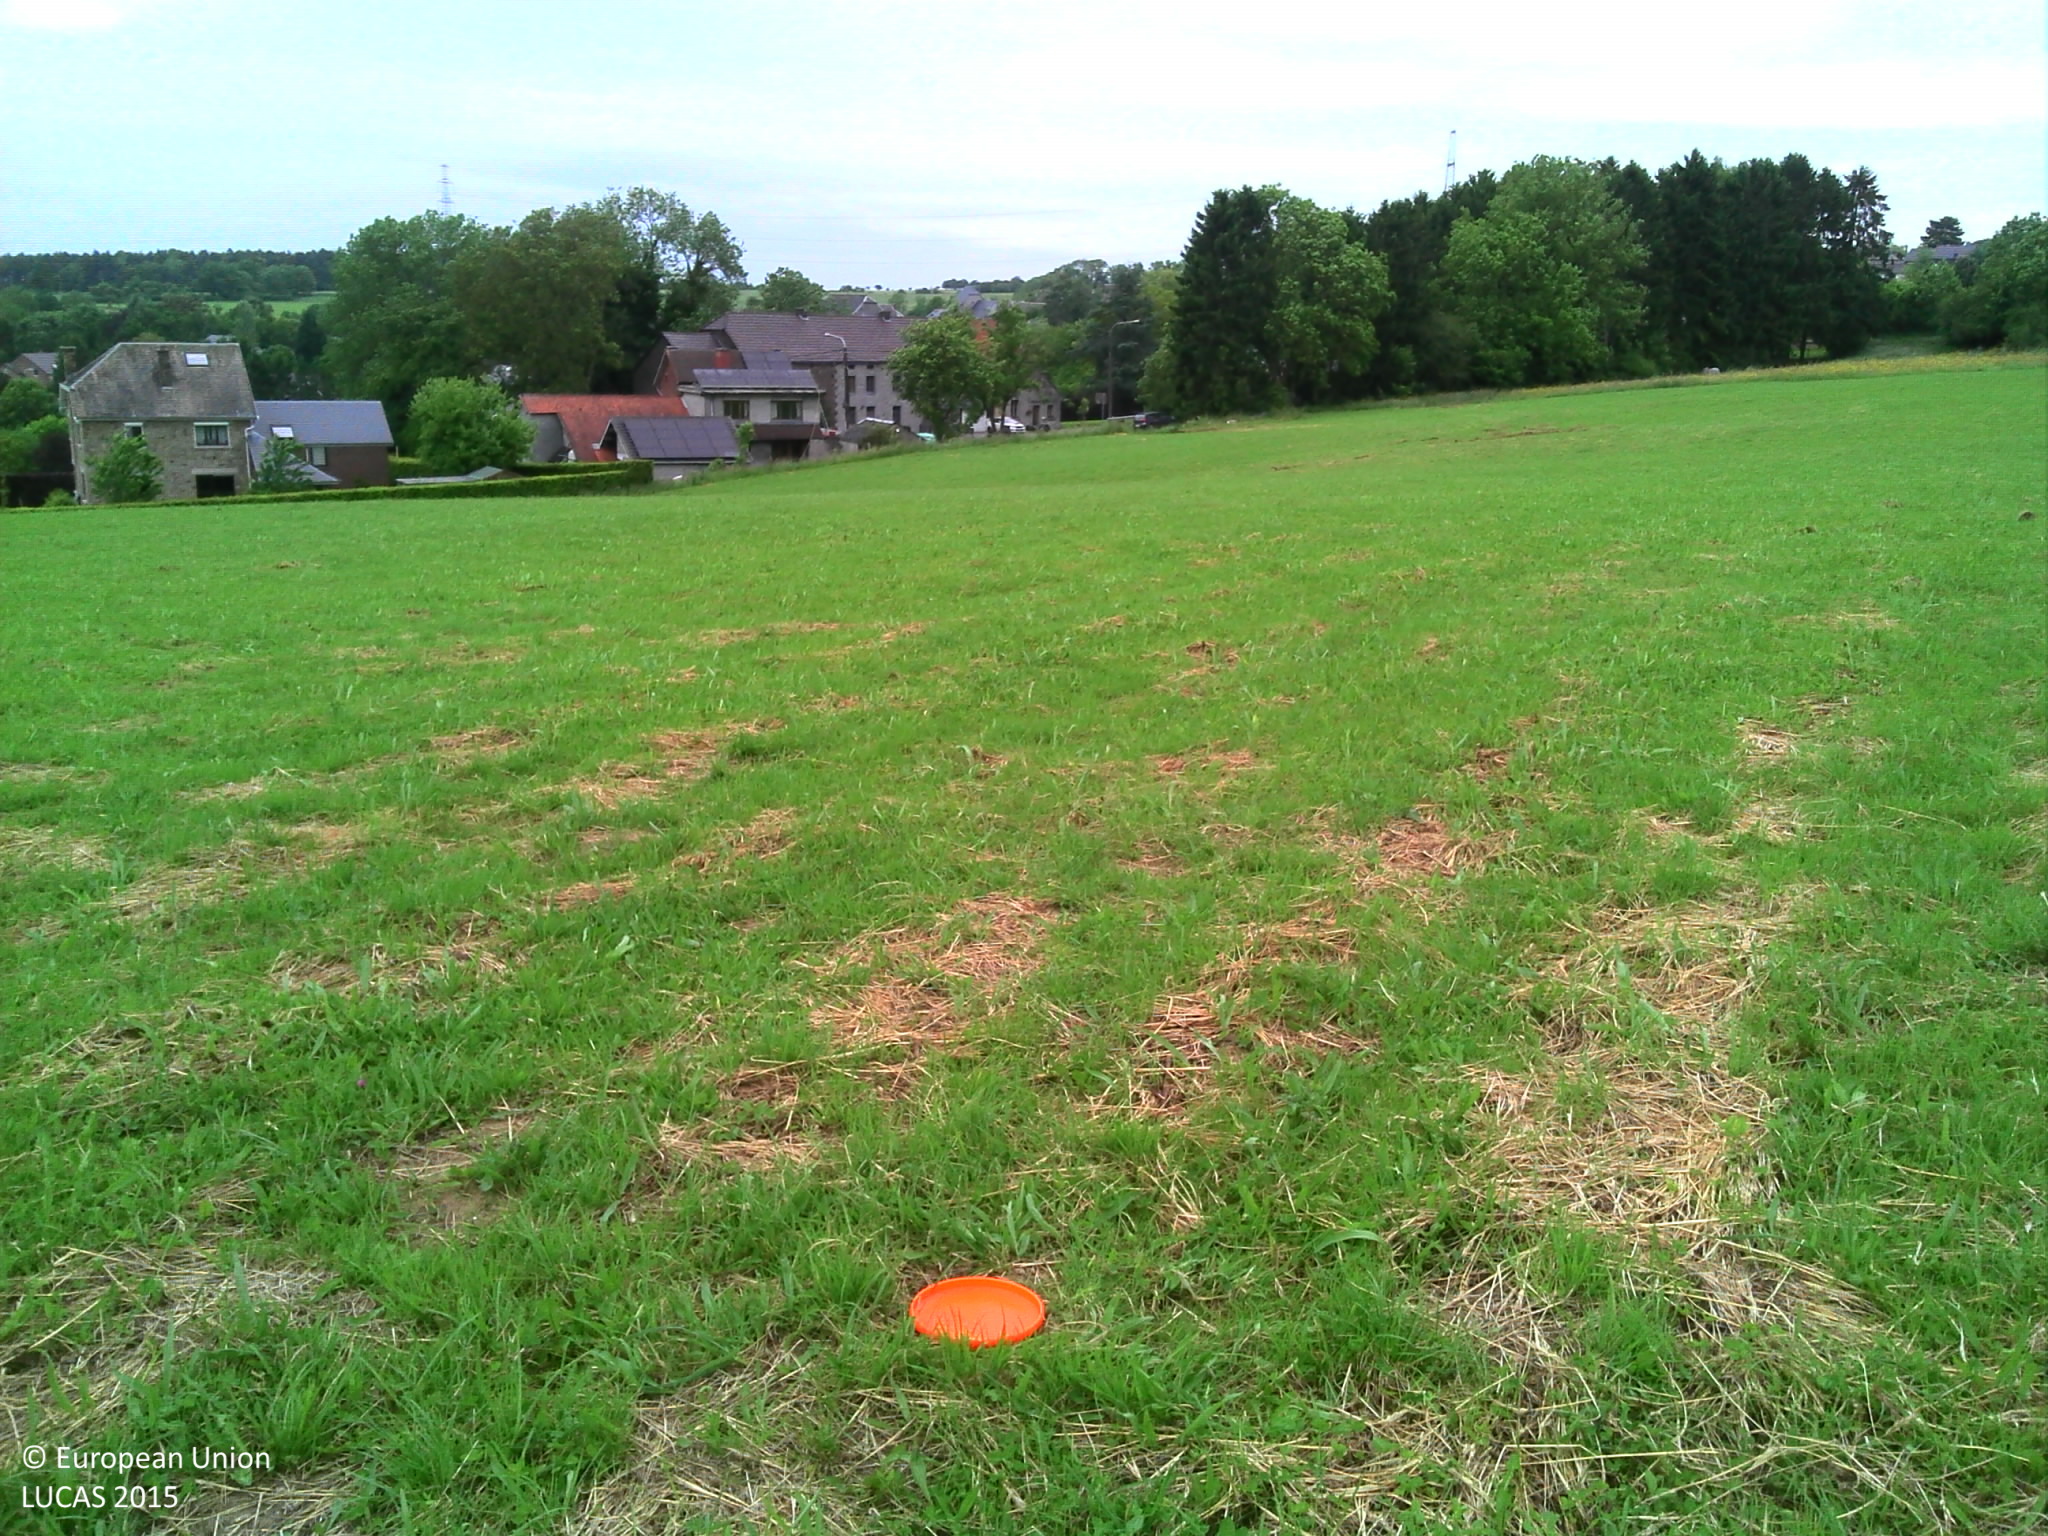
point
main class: Grassland
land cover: Grassland without tree/shrub cover
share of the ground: > 75 %
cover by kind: herbaceous plants 100 %
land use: Agriculture (excluding fallow land and kitchen gardens)
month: June
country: BE
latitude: 50.4222
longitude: 5.5647
